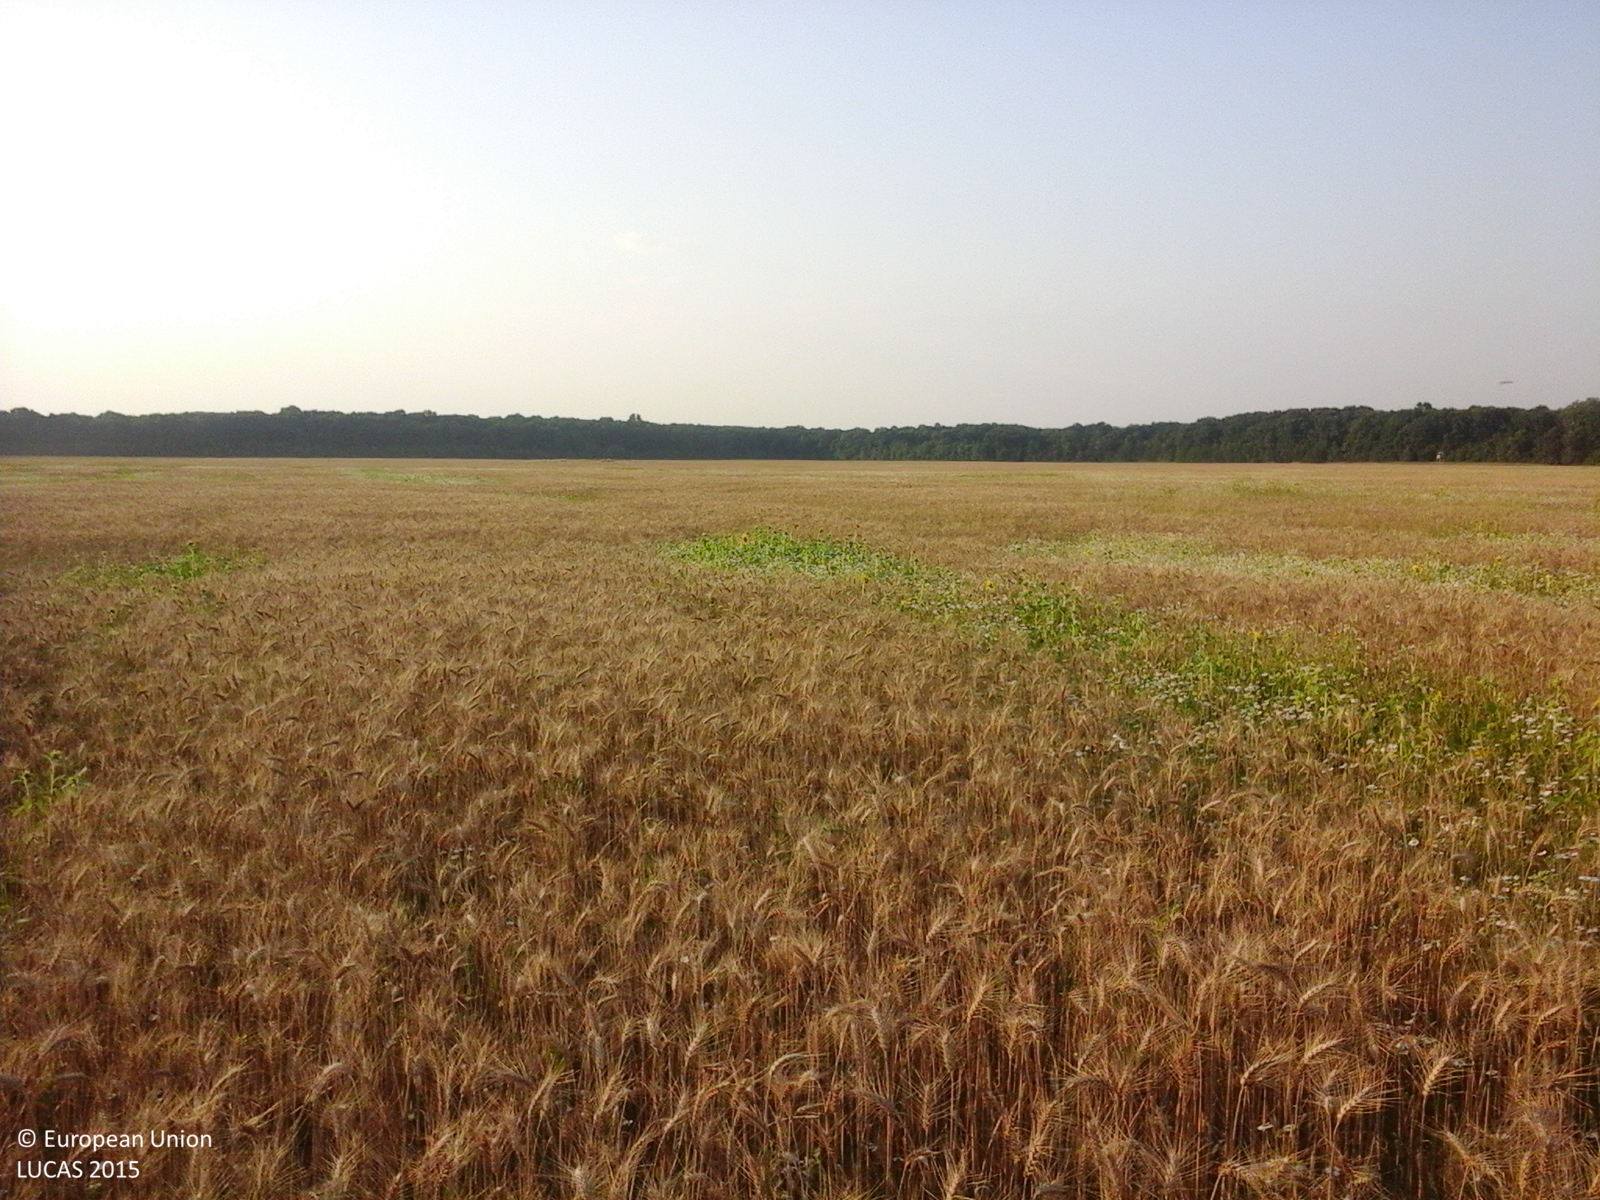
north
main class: Cropland
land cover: Common wheat
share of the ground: > 75 %
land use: Agriculture (excluding fallow land and kitchen gardens)
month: July
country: RO
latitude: 44.7080
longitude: 25.6861
